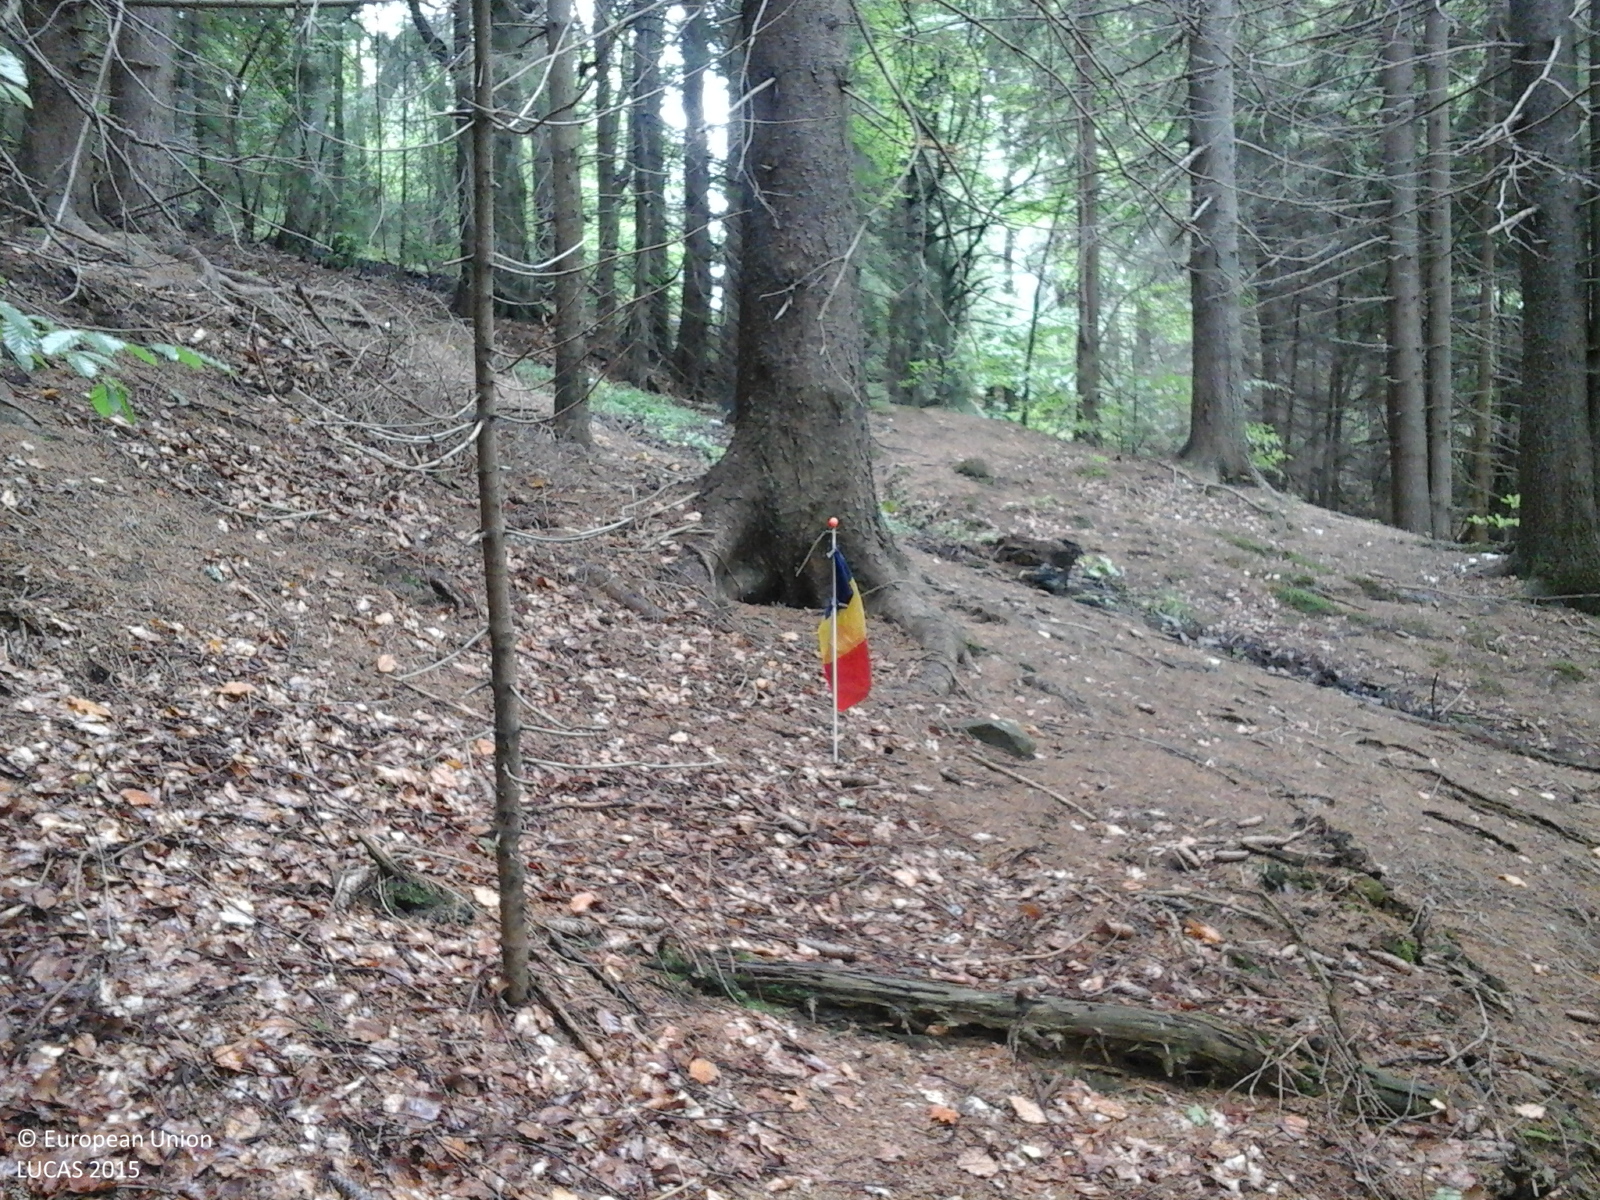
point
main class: Woodland
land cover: Spruce dominated mixed woodland
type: alpine coniferous forest
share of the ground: > 75 %
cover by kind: coniferous forest trees 70 %, broadleaved forest trees 30 %
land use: Forestry
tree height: > 5 m
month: September
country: RO
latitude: 47.6672
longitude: 23.8923
